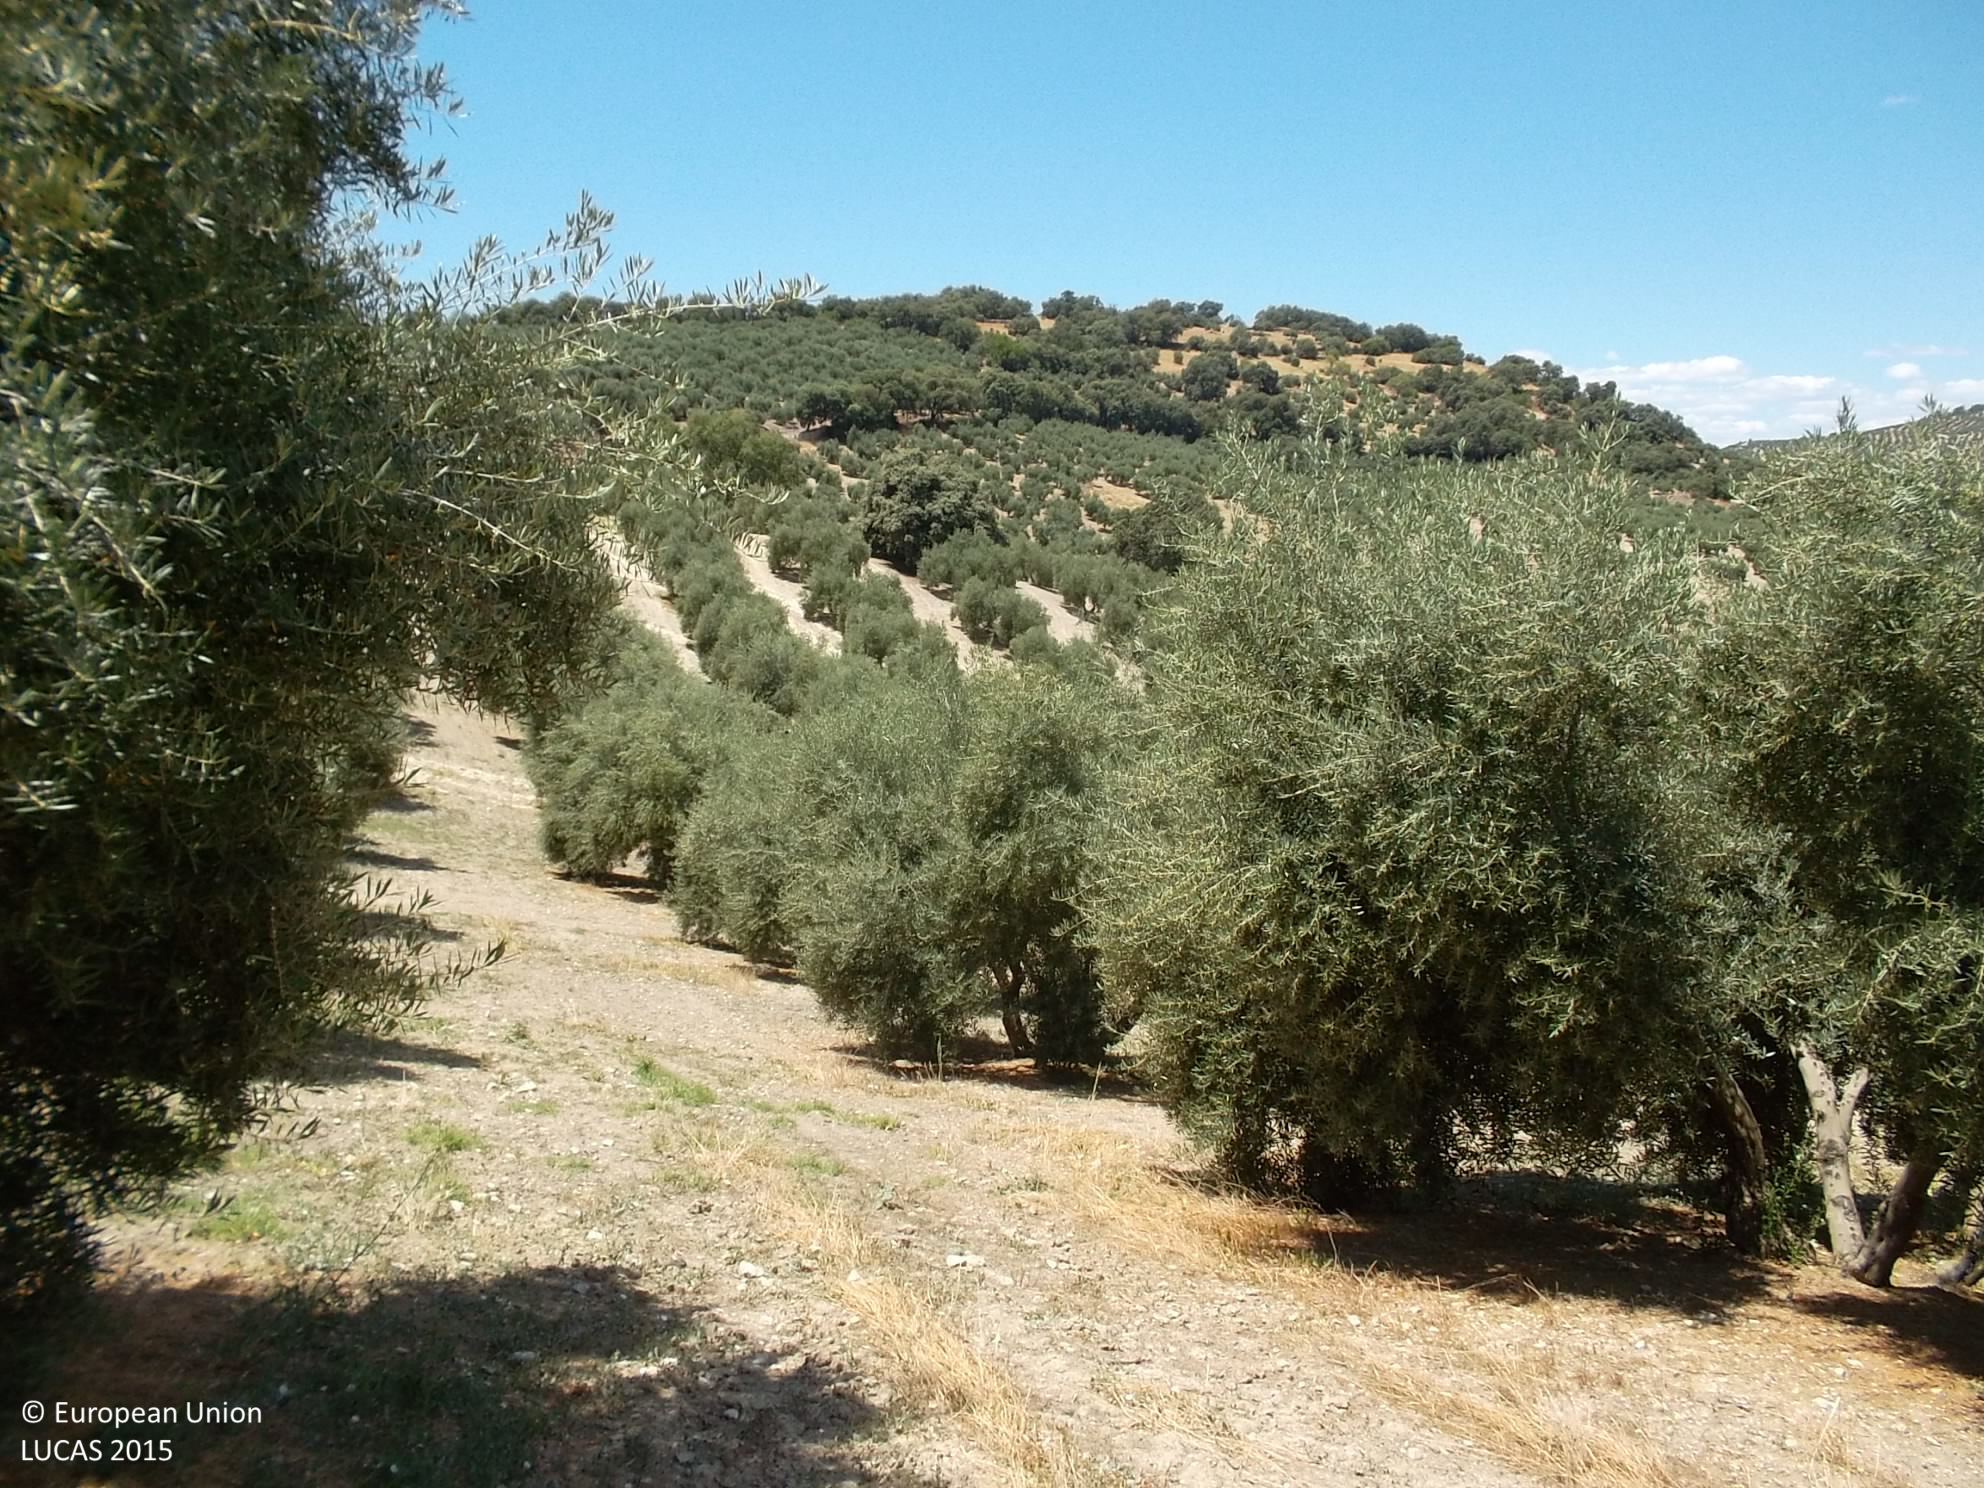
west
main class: Cropland
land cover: Olive groves
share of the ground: 25 - 50 %
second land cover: Other bare soil
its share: > 75 %
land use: Agriculture (excluding fallow land and kitchen gardens)
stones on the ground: < 10 %
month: June
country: ES
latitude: 37.9570
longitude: -2.9587
